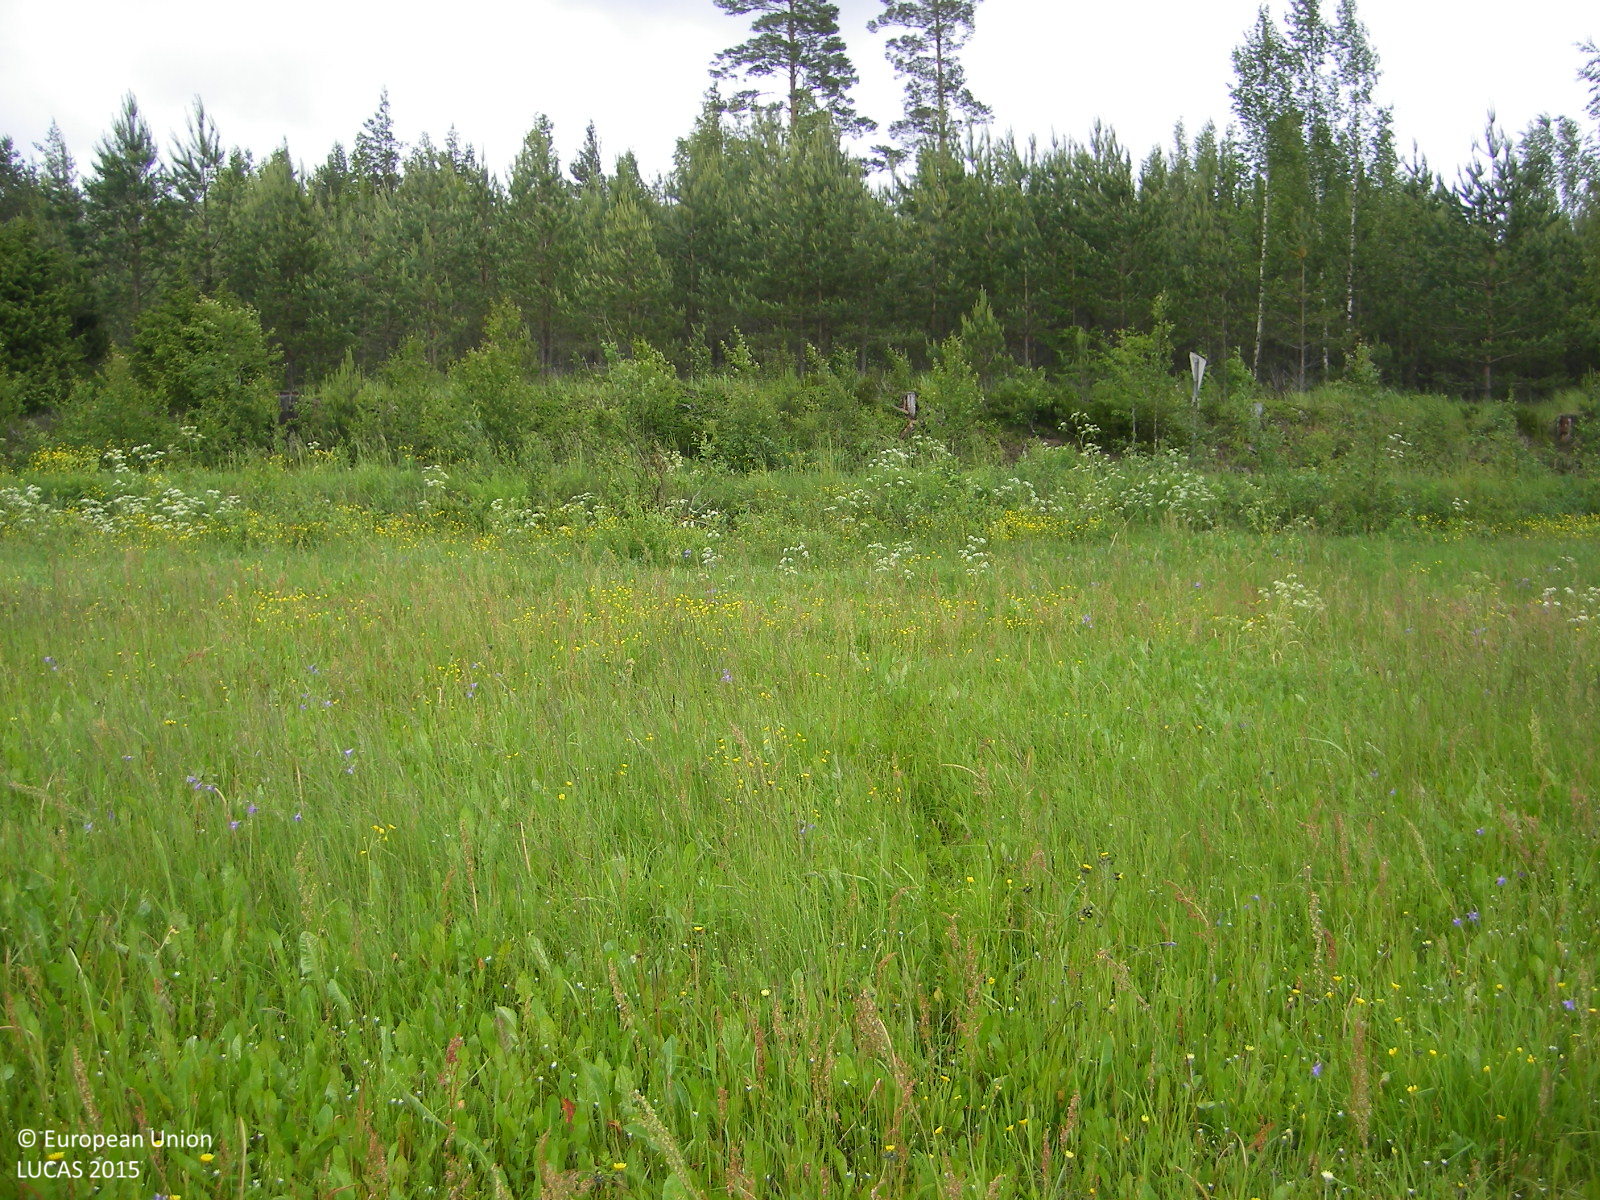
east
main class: Grassland
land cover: Spontaneously vegetated surfaces
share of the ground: > 75 %
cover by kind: herbaceous plants 100 %
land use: Fallow land
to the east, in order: Spontaneously vegetated surfaces; Ditches and canals; Grass margins; Paved roads, cycling and walking lanes; Grass margins; Ditches and canals; Pine dominated coniferous woodland
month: June
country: FI
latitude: 60.2854
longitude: 23.2320
